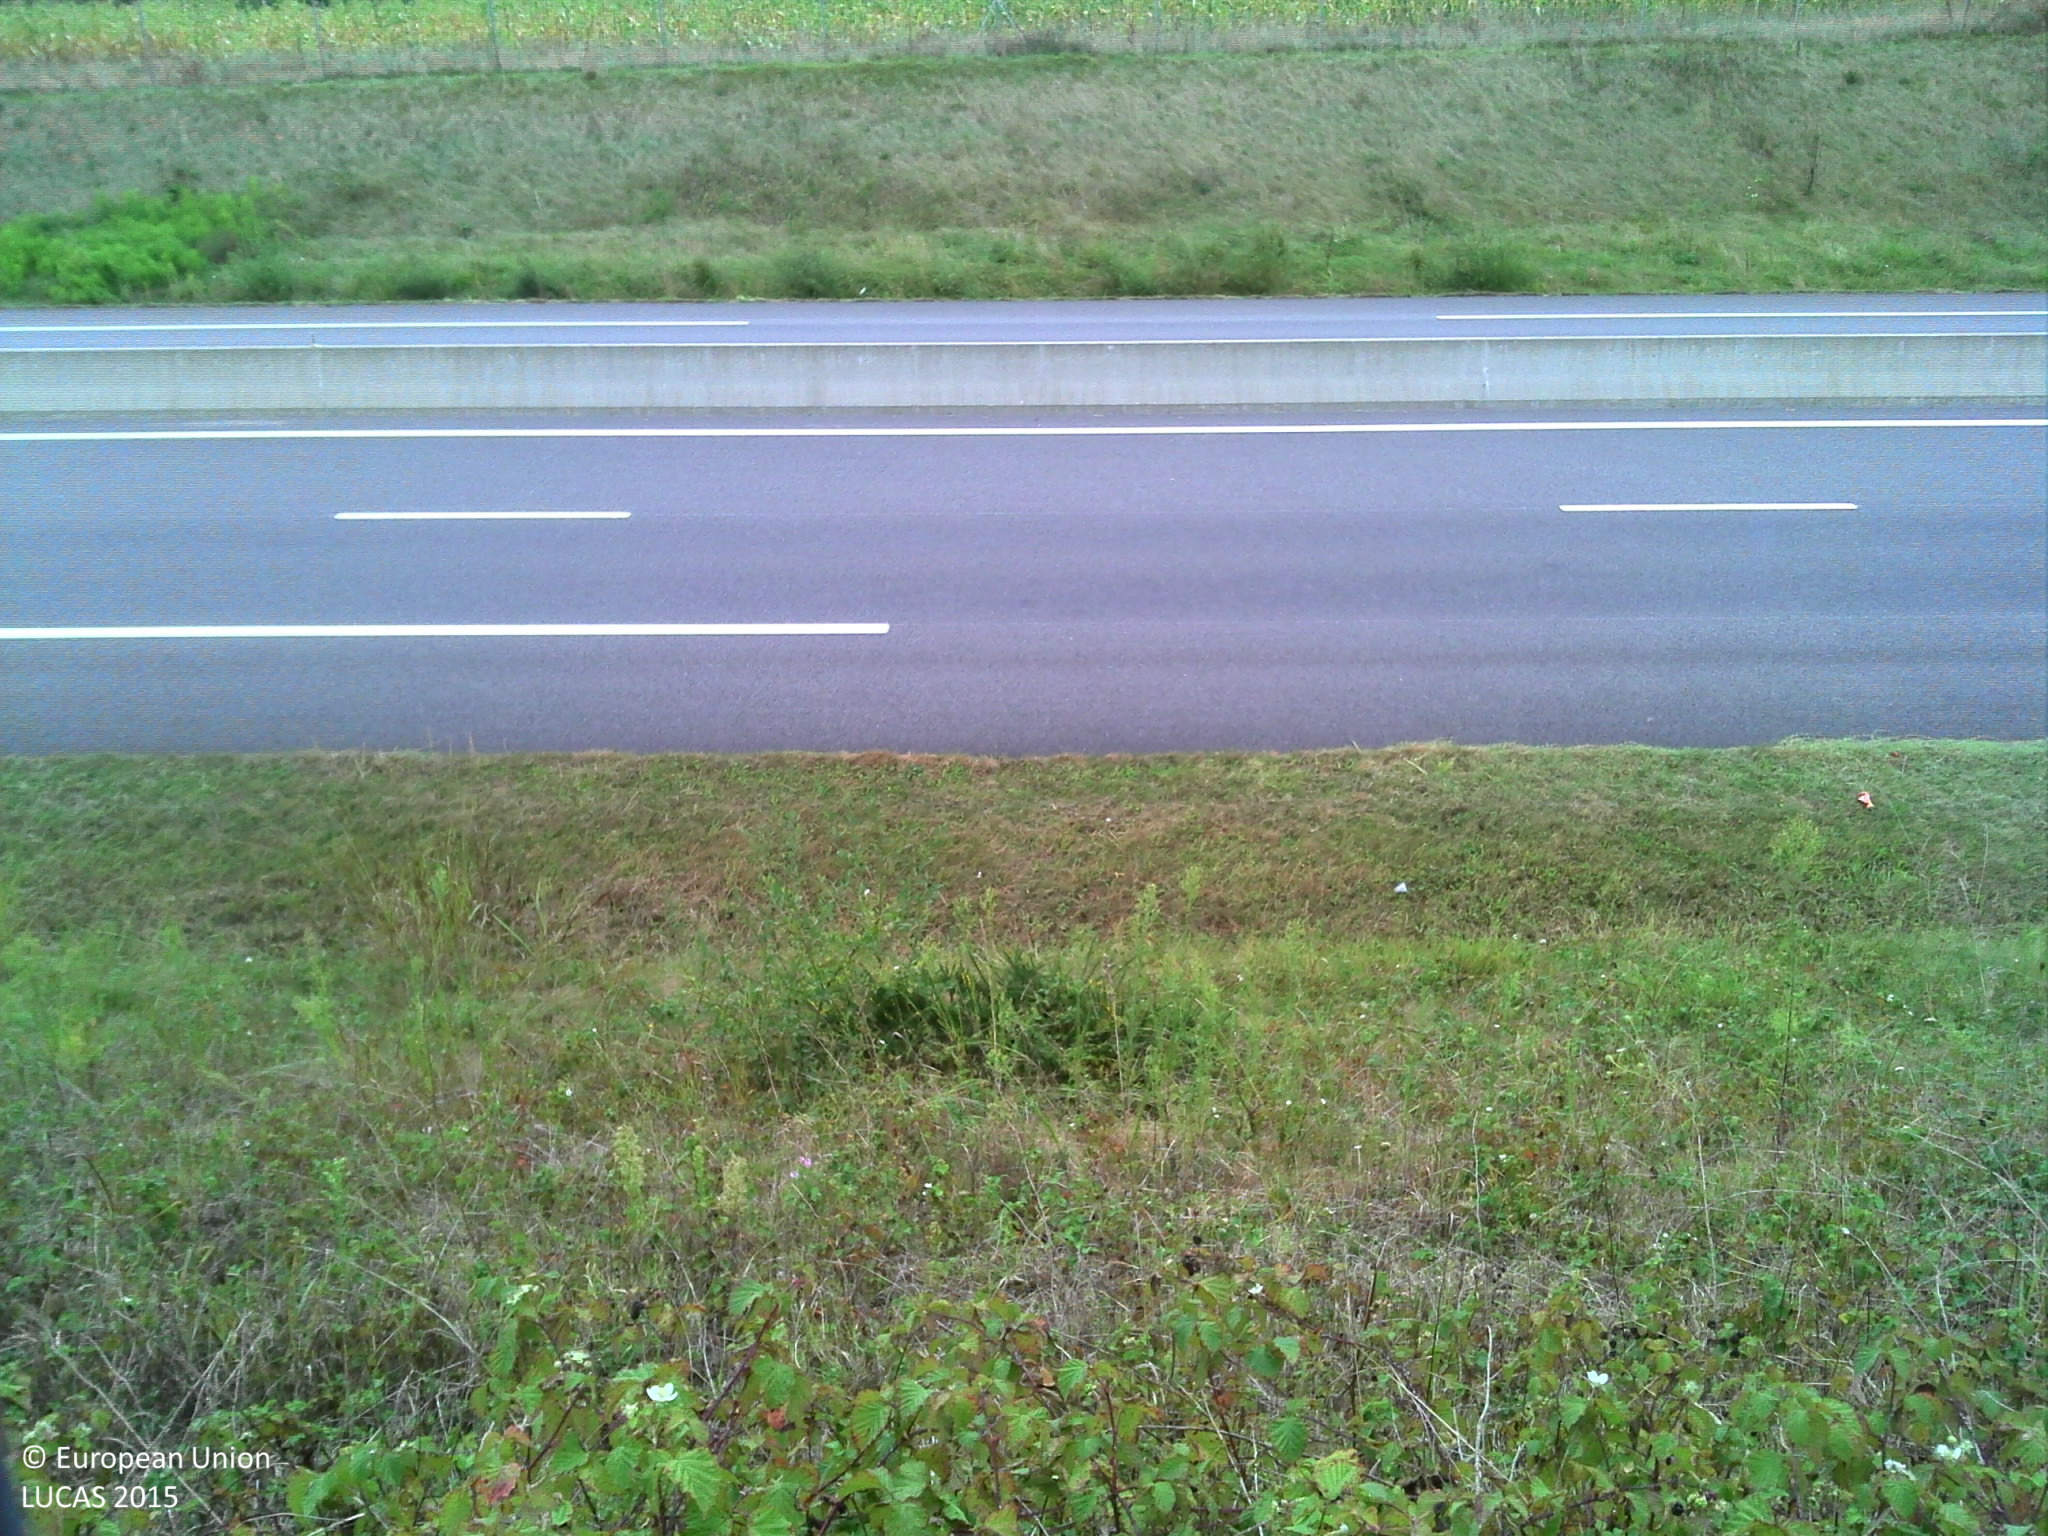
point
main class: Grassland
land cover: Grassland without tree/shrub cover
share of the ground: > 75 %
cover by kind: herbaceous plants 95 %, shrubs 5 %
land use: Road transport
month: September
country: FR
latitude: 43.4221
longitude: -0.4453
